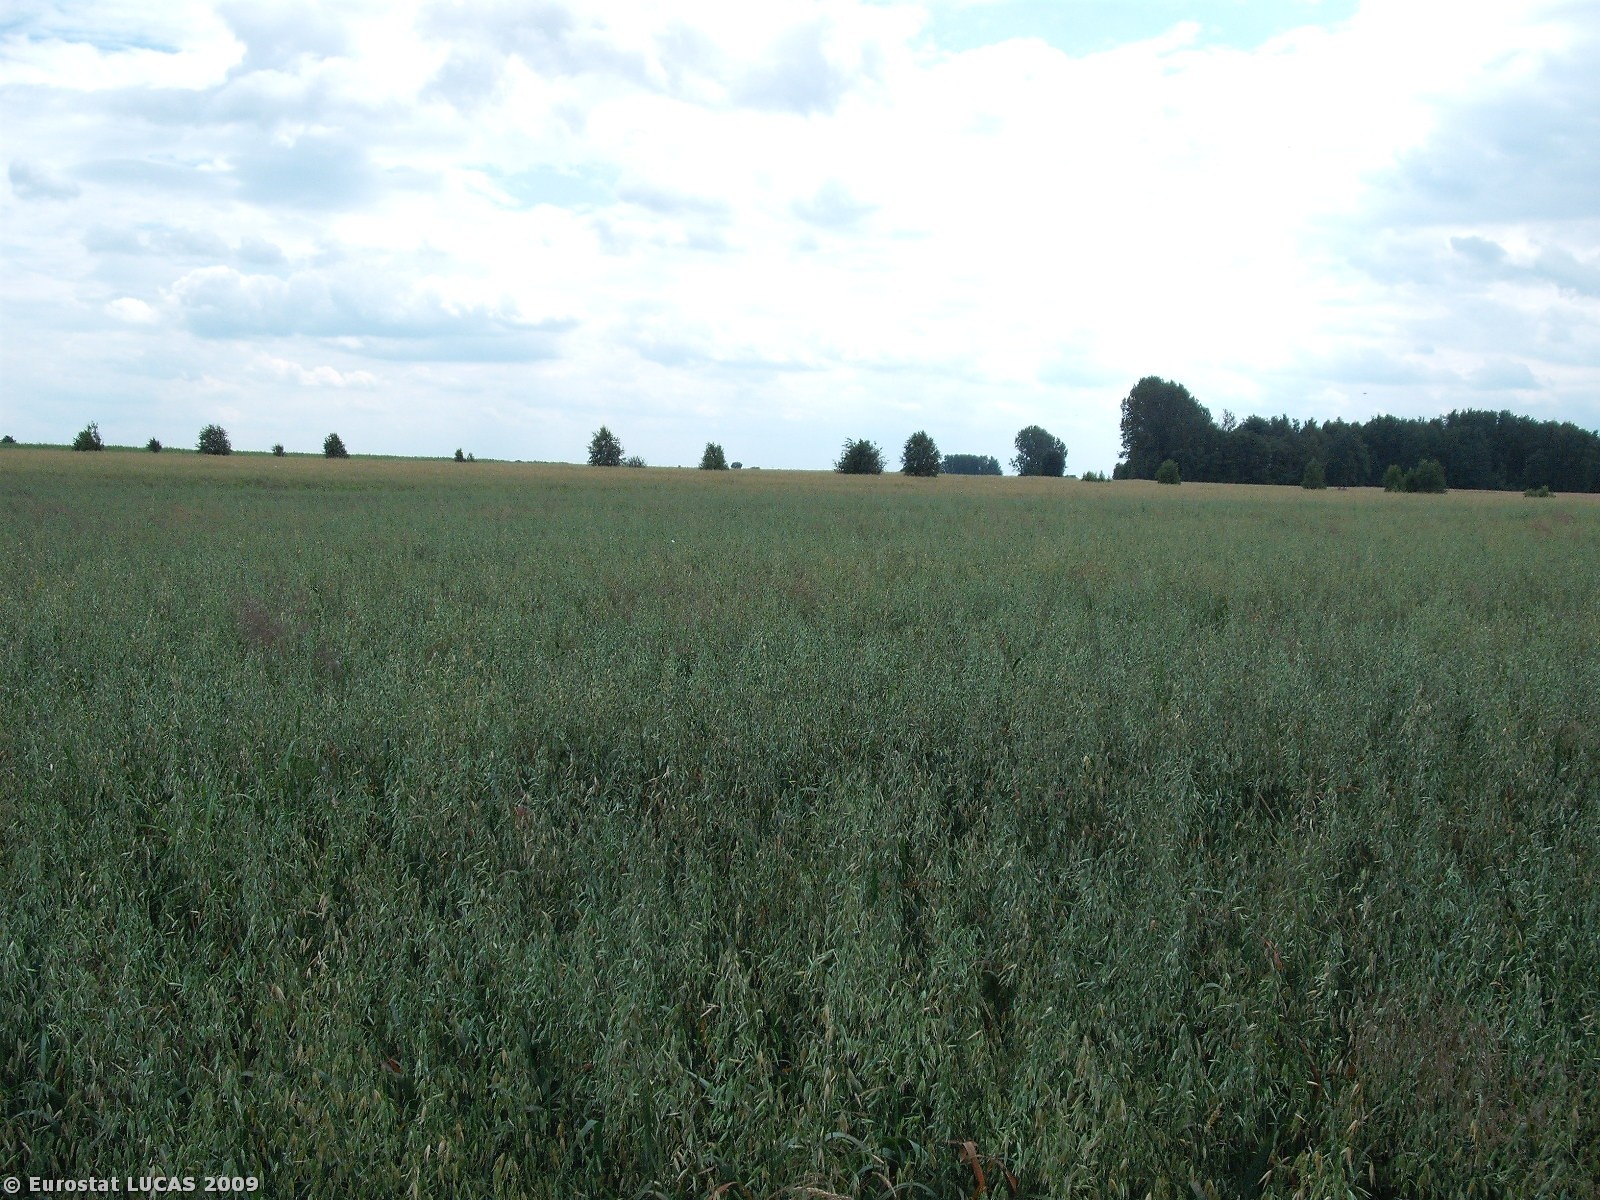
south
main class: Cropland
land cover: Triticale
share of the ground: > 75 %
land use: Agriculture (excluding fallow land and kitchen gardens)
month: July
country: PL
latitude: 51.5267
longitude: 20.9261
